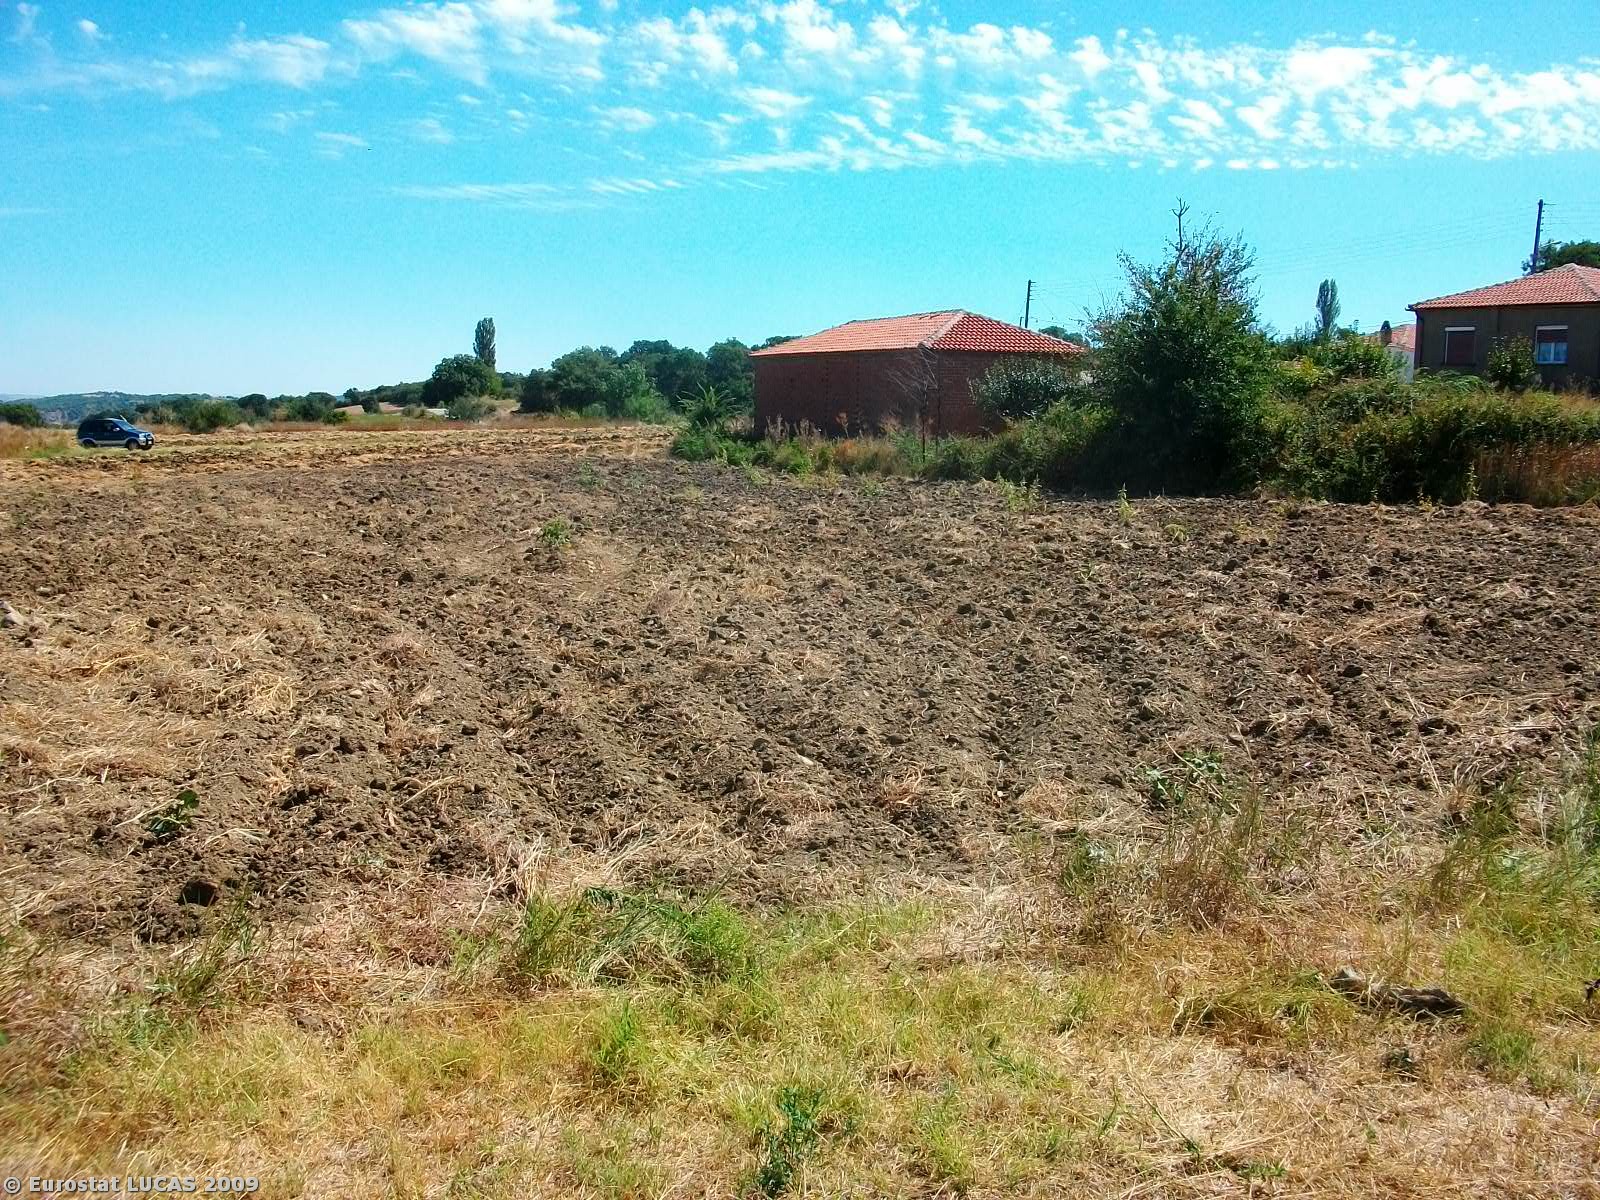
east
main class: Cropland
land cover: Lucerne
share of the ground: < 10 %
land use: Agriculture (excluding fallow land and kitchen gardens)
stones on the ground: < 10 %
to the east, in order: Lucerne; Grass margins; Common wheat; Grass margins; Common wheat; Tracks; Common wheat; Shruby margins; Tracks; Lucerne; Common wheat
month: August
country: GR
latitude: 41.3494
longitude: 26.3639
